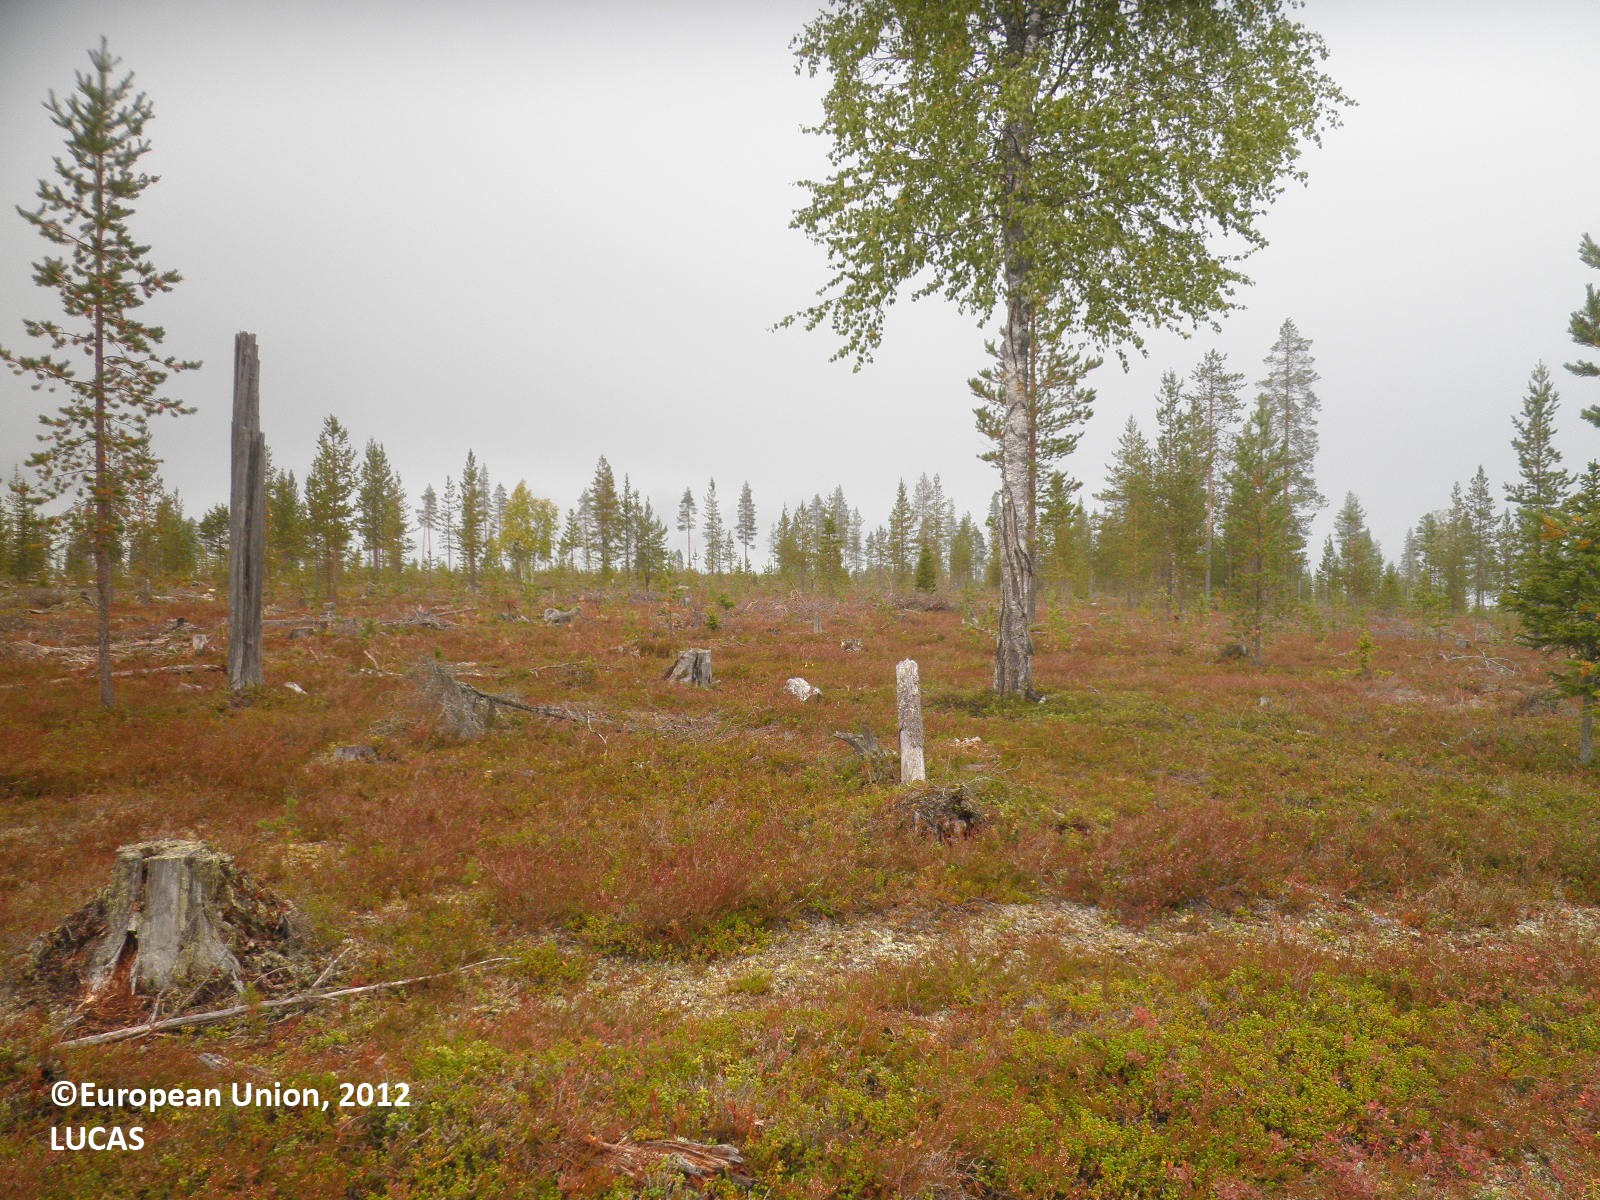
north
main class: Shrubland
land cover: Shrubland with sparse tree cover
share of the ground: > 75 %
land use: Forestry
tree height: > 5 m
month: September
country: FI
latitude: 67.4180
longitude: 28.4469
